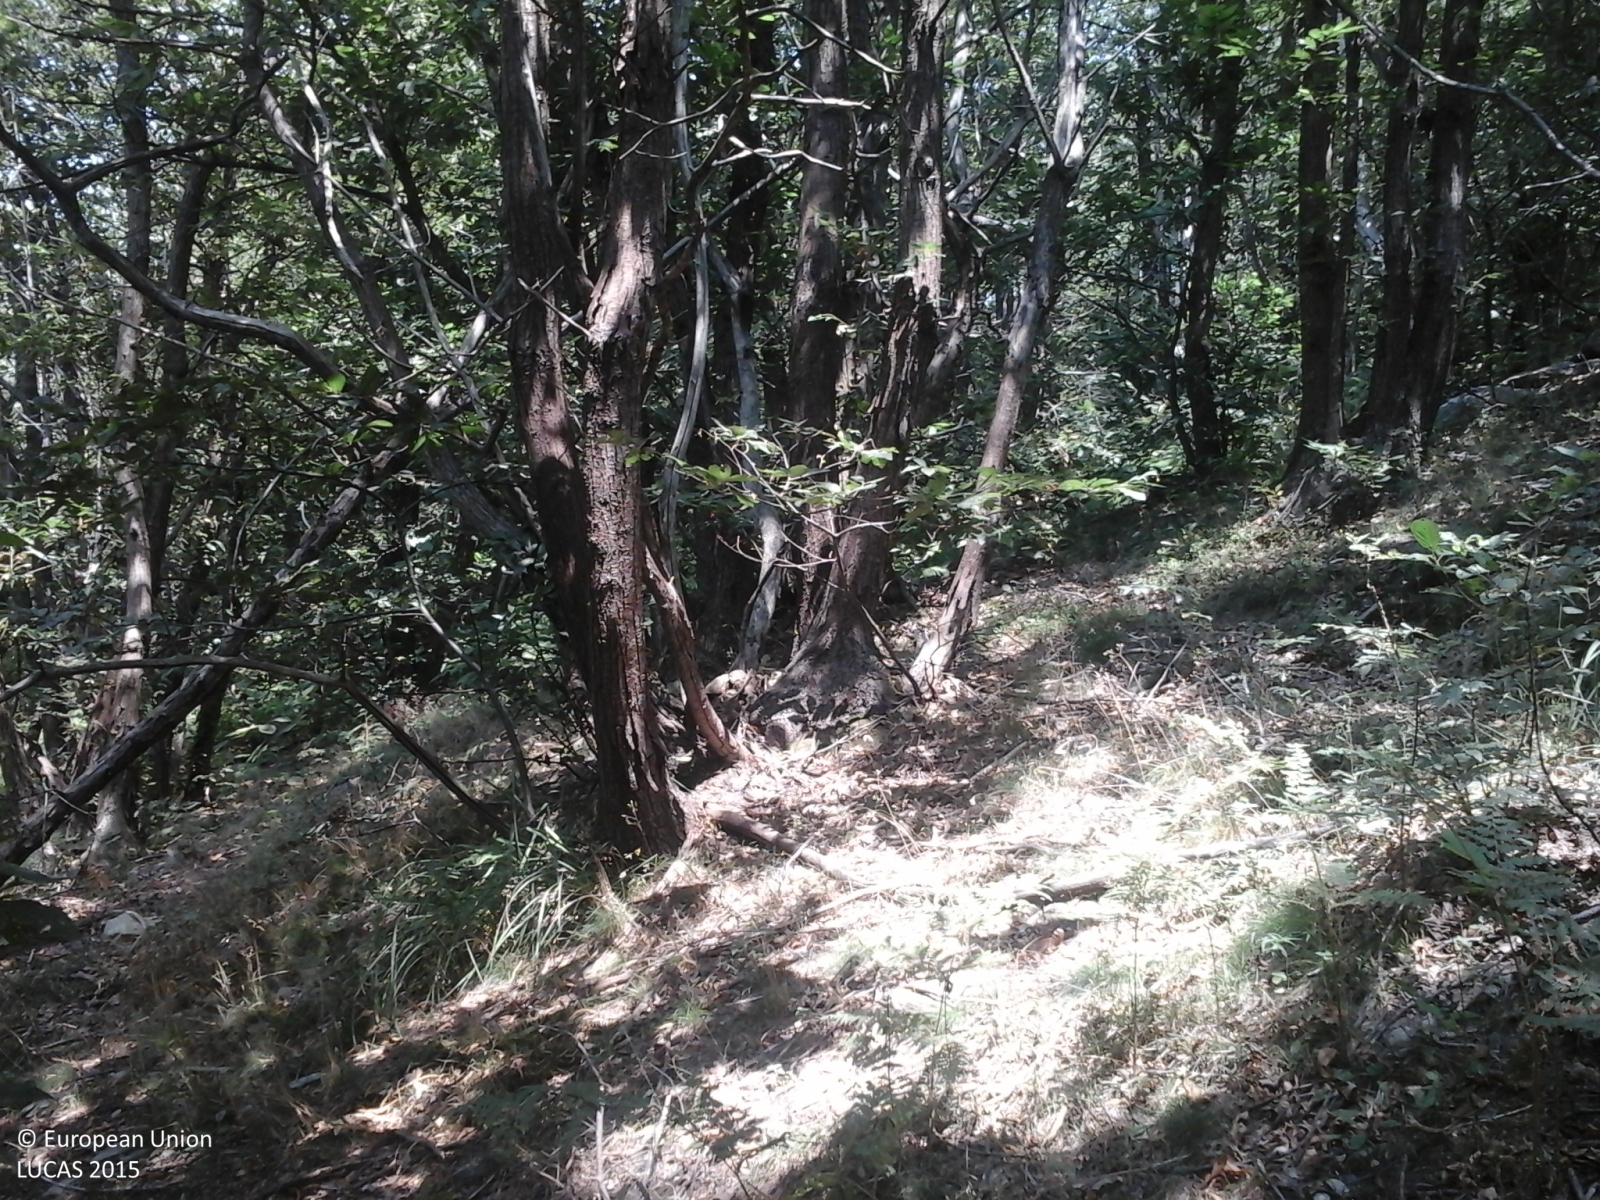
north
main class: Woodland
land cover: Broadleaved woodland
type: thermophilous deciduous forest
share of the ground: > 75 %
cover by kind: broadleaved forest trees 100 %
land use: Forestry
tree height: > 5 m
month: July
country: IT
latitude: 44.7829
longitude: 7.2373
